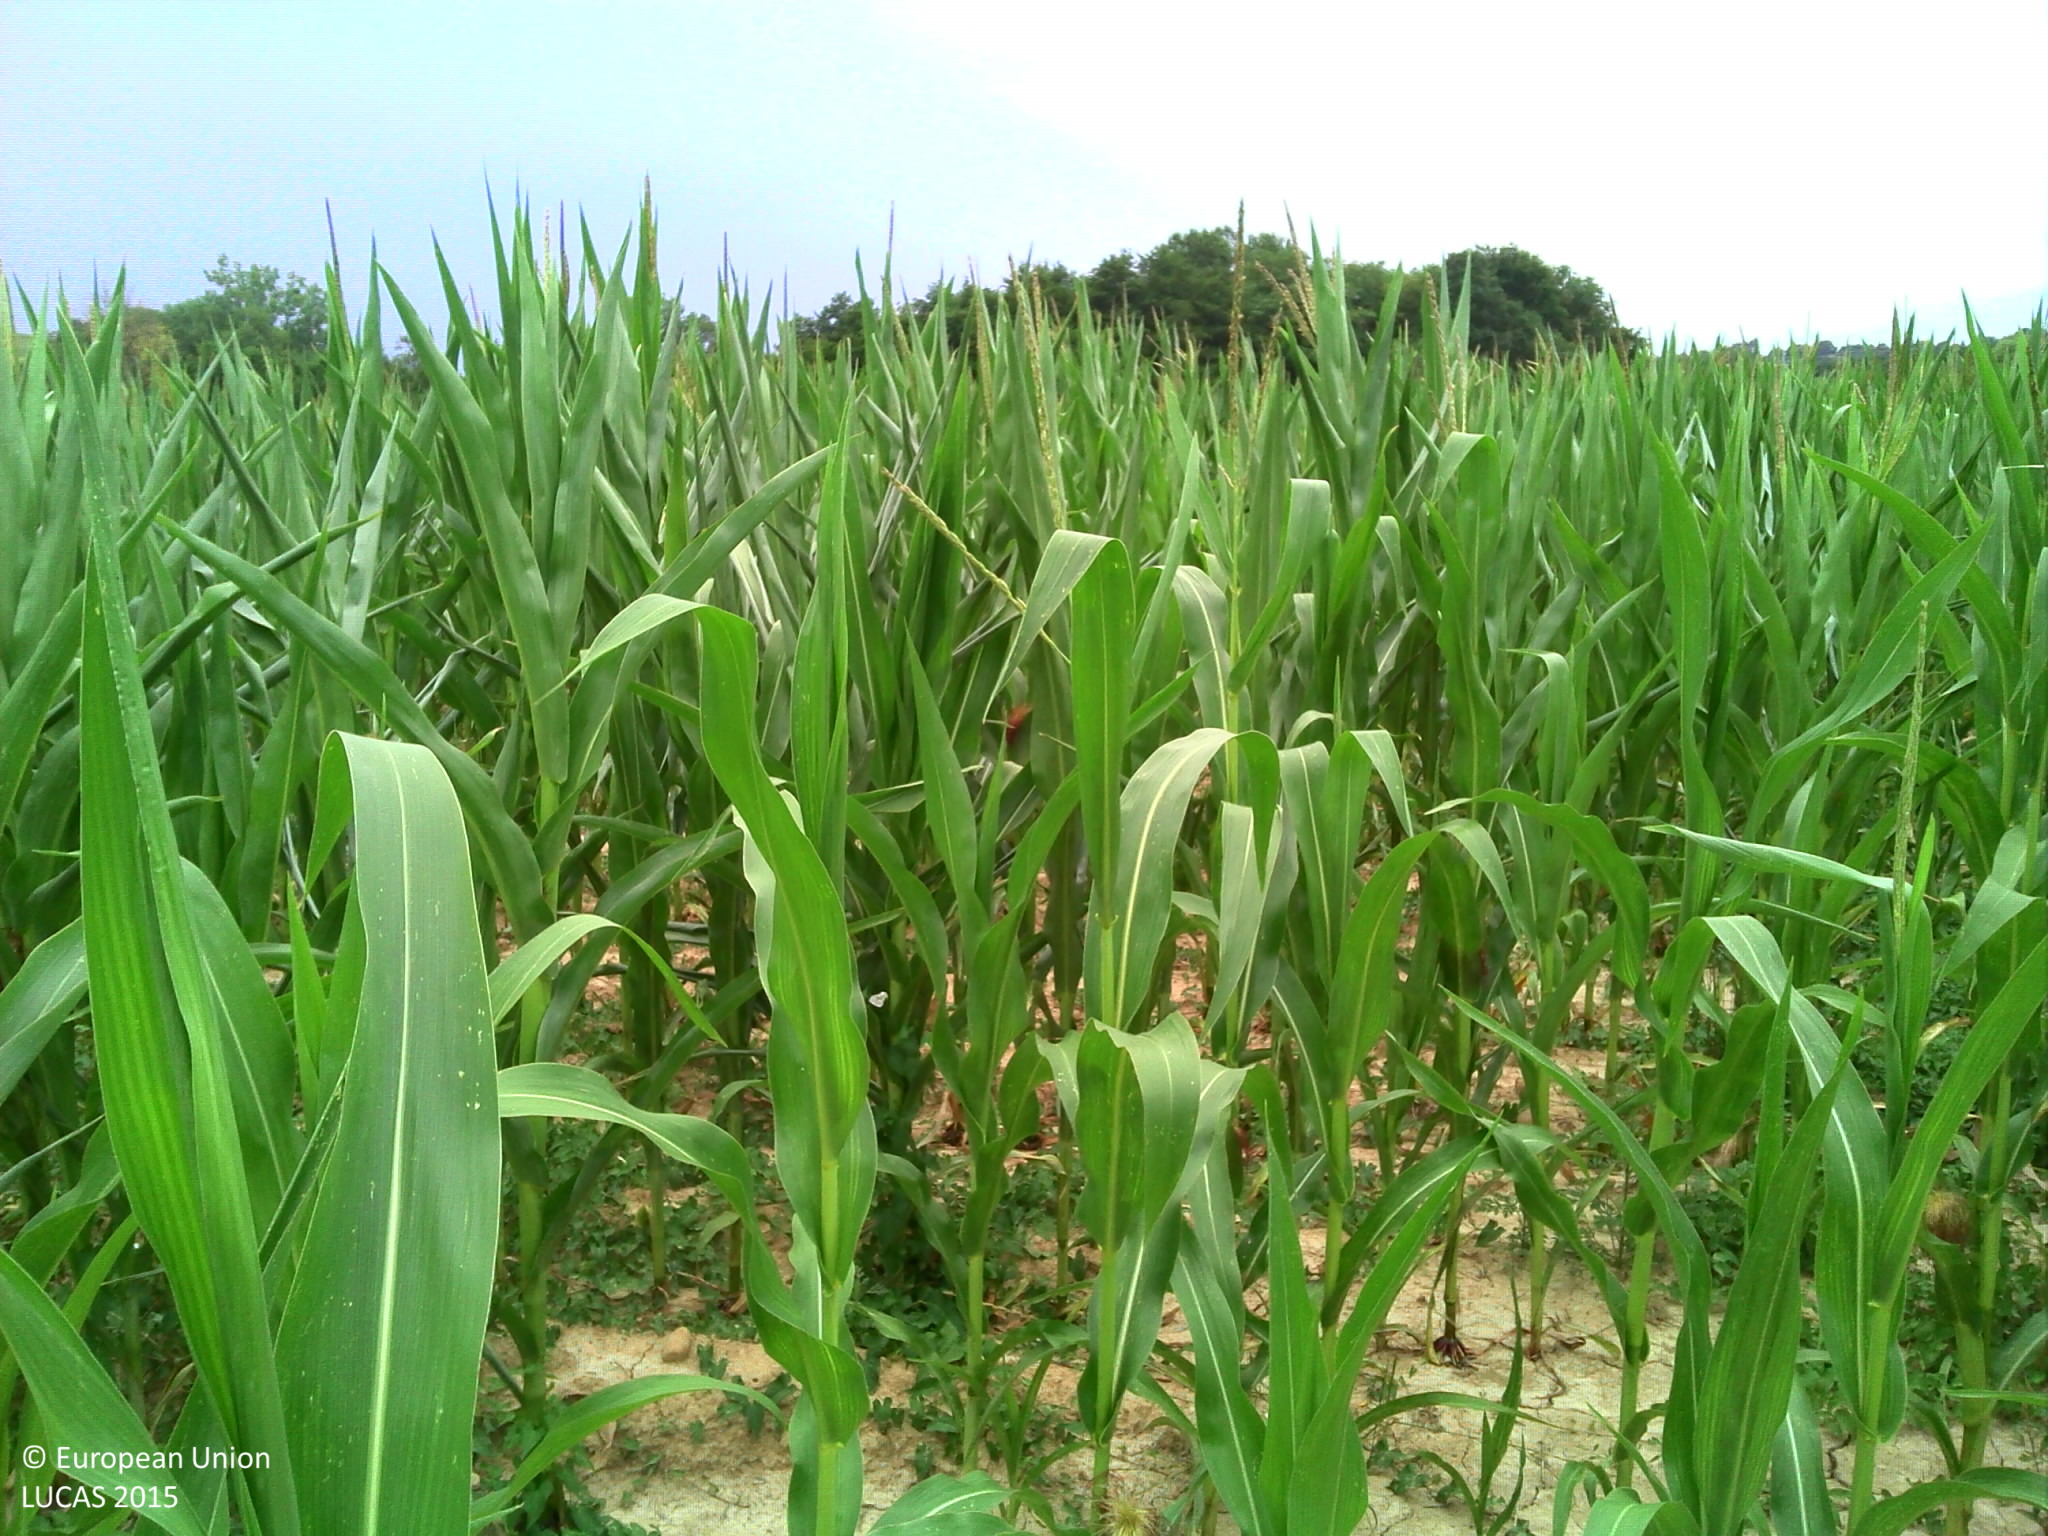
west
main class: Cropland
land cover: Maize
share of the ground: > 75 %
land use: Agriculture (excluding fallow land and kitchen gardens)
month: July
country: FR
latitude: 45.4392
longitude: 4.9804
